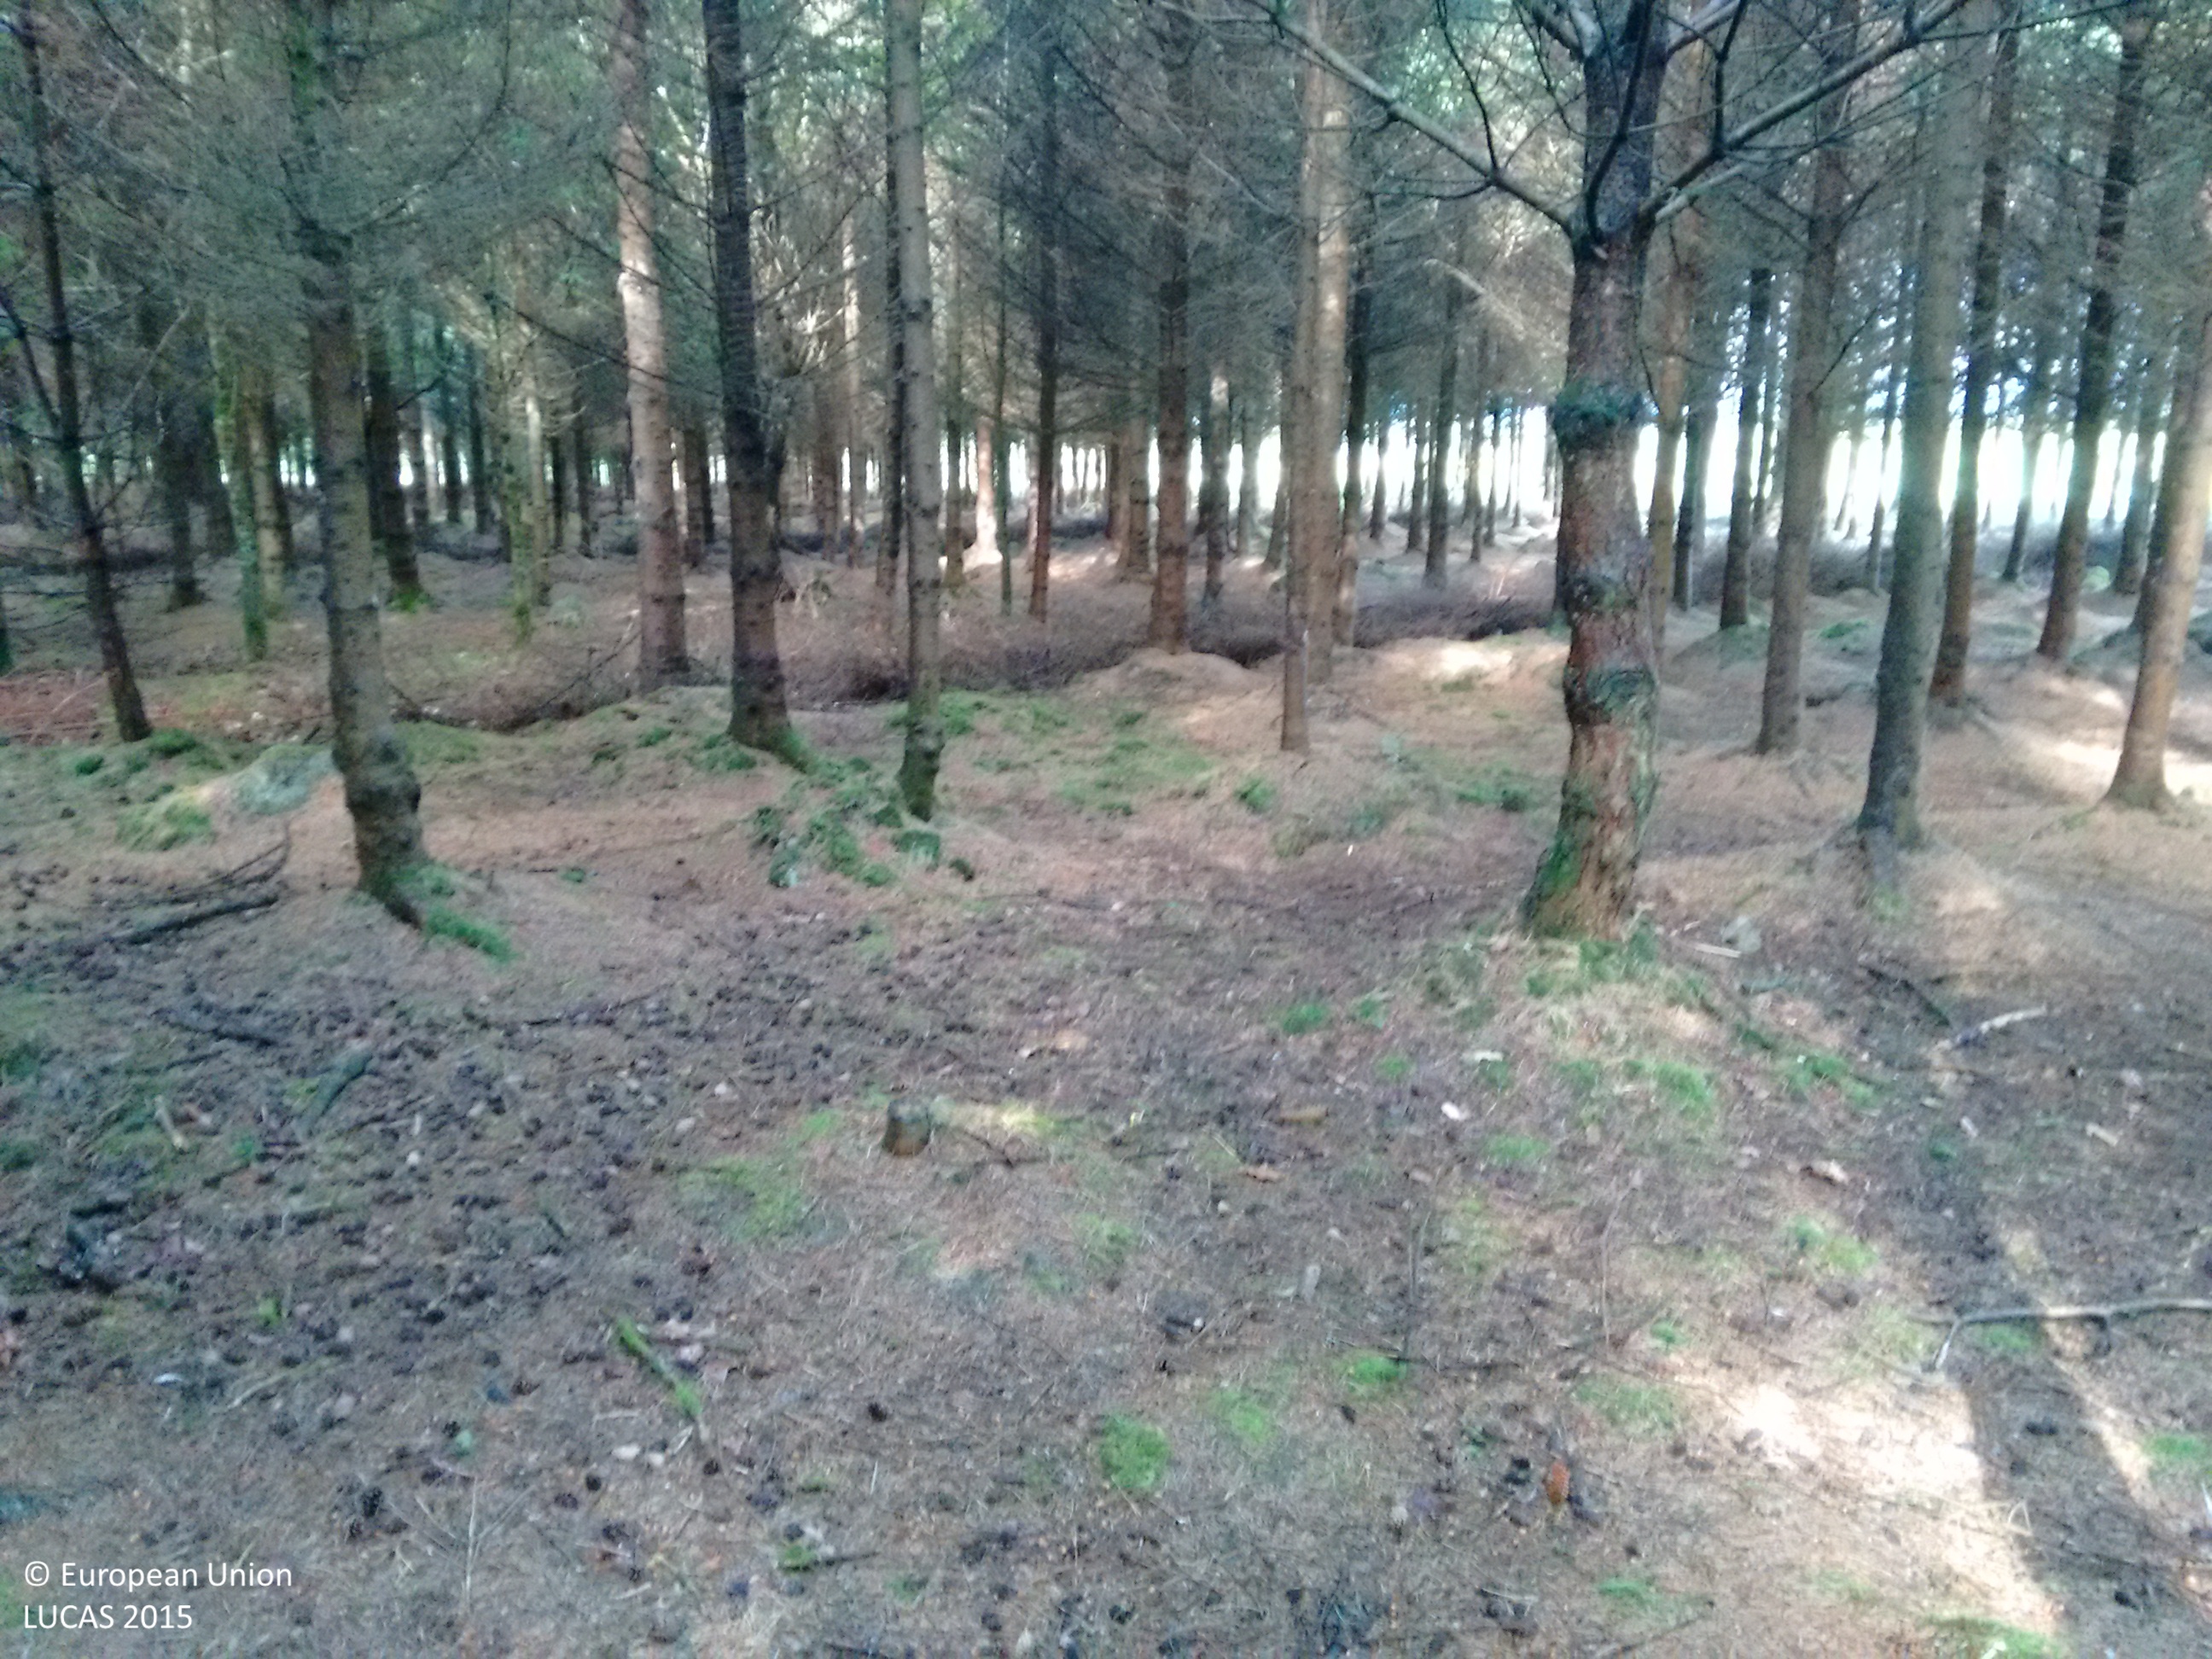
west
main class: Woodland
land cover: Spruce dominated coniferous woodland
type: exotic forest
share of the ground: > 75 %
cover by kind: coniferous forest trees 95 %, lichens and mosses 5 %
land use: Forestry
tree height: > 5 m
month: June
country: IE
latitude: 52.2816
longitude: -7.1058
